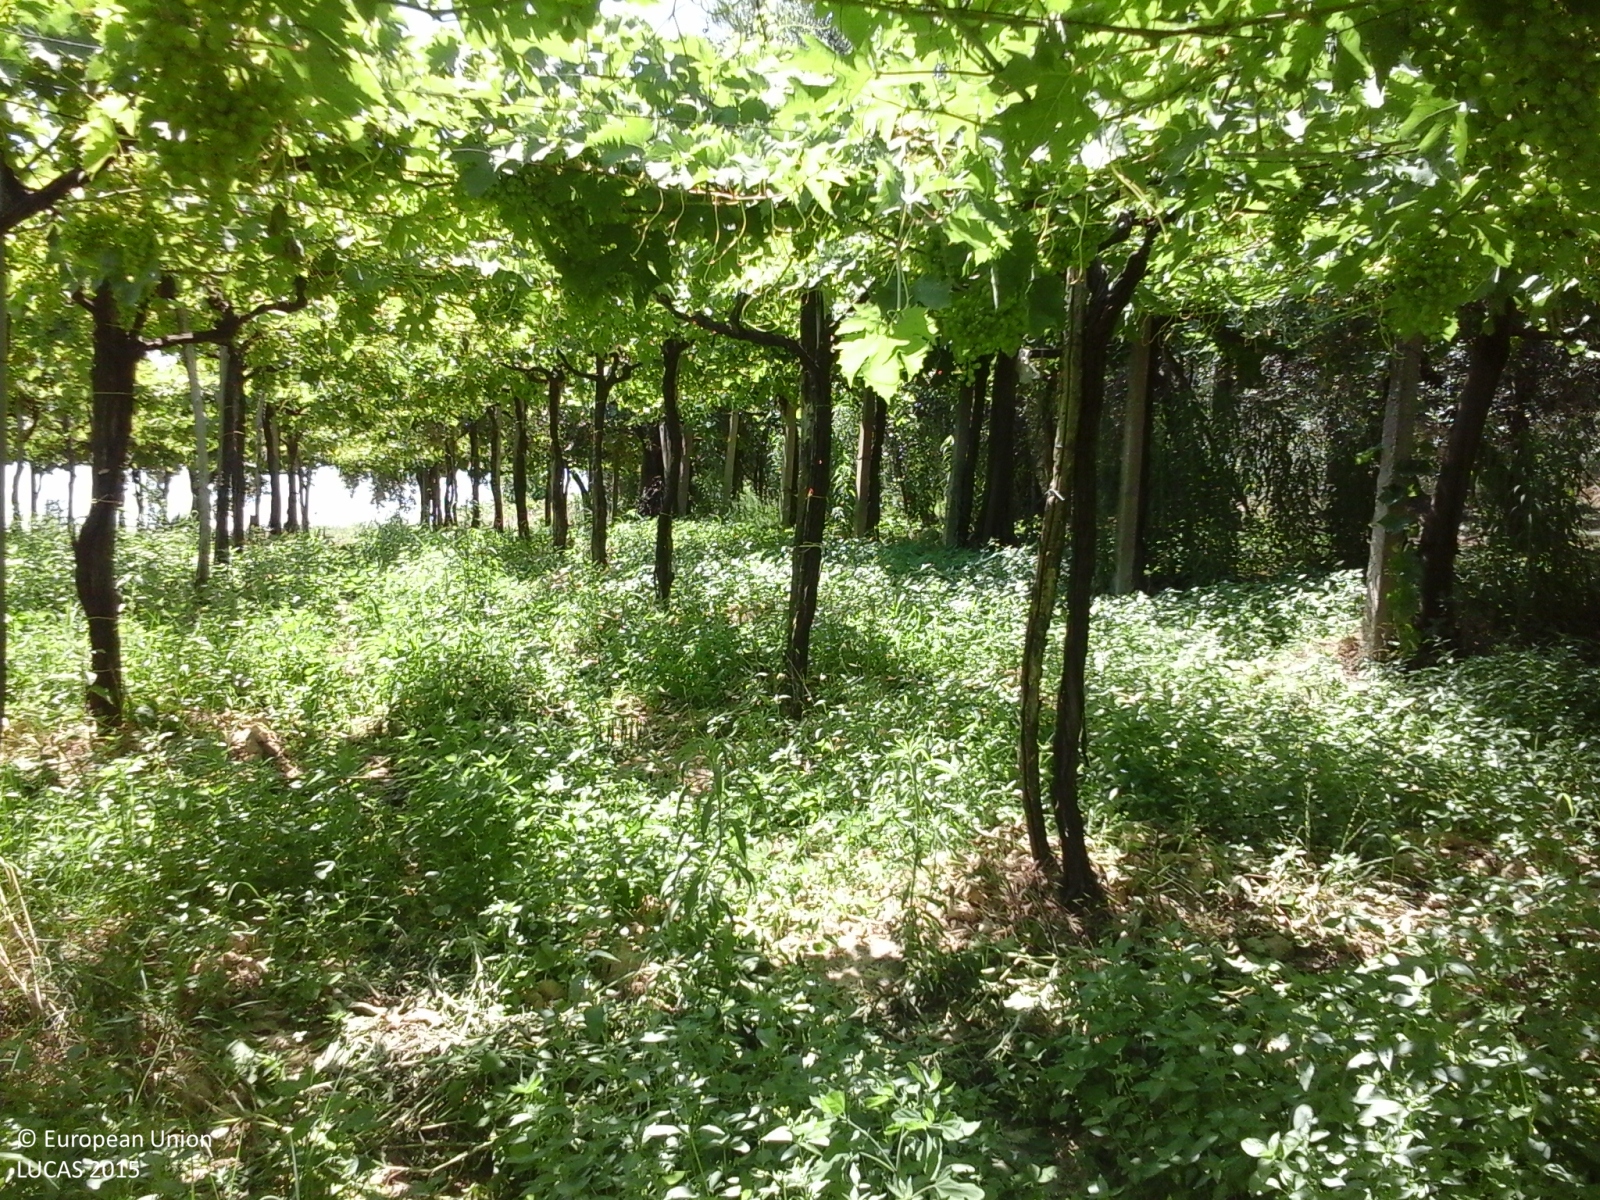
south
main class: Cropland
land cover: Vineyards
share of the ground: 25 - 50 %
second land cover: Spontaneously vegetated surfaces
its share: 25 - 50 %
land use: Agriculture (excluding fallow land and kitchen gardens)
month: July
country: IT
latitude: 42.2907
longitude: 14.3167
